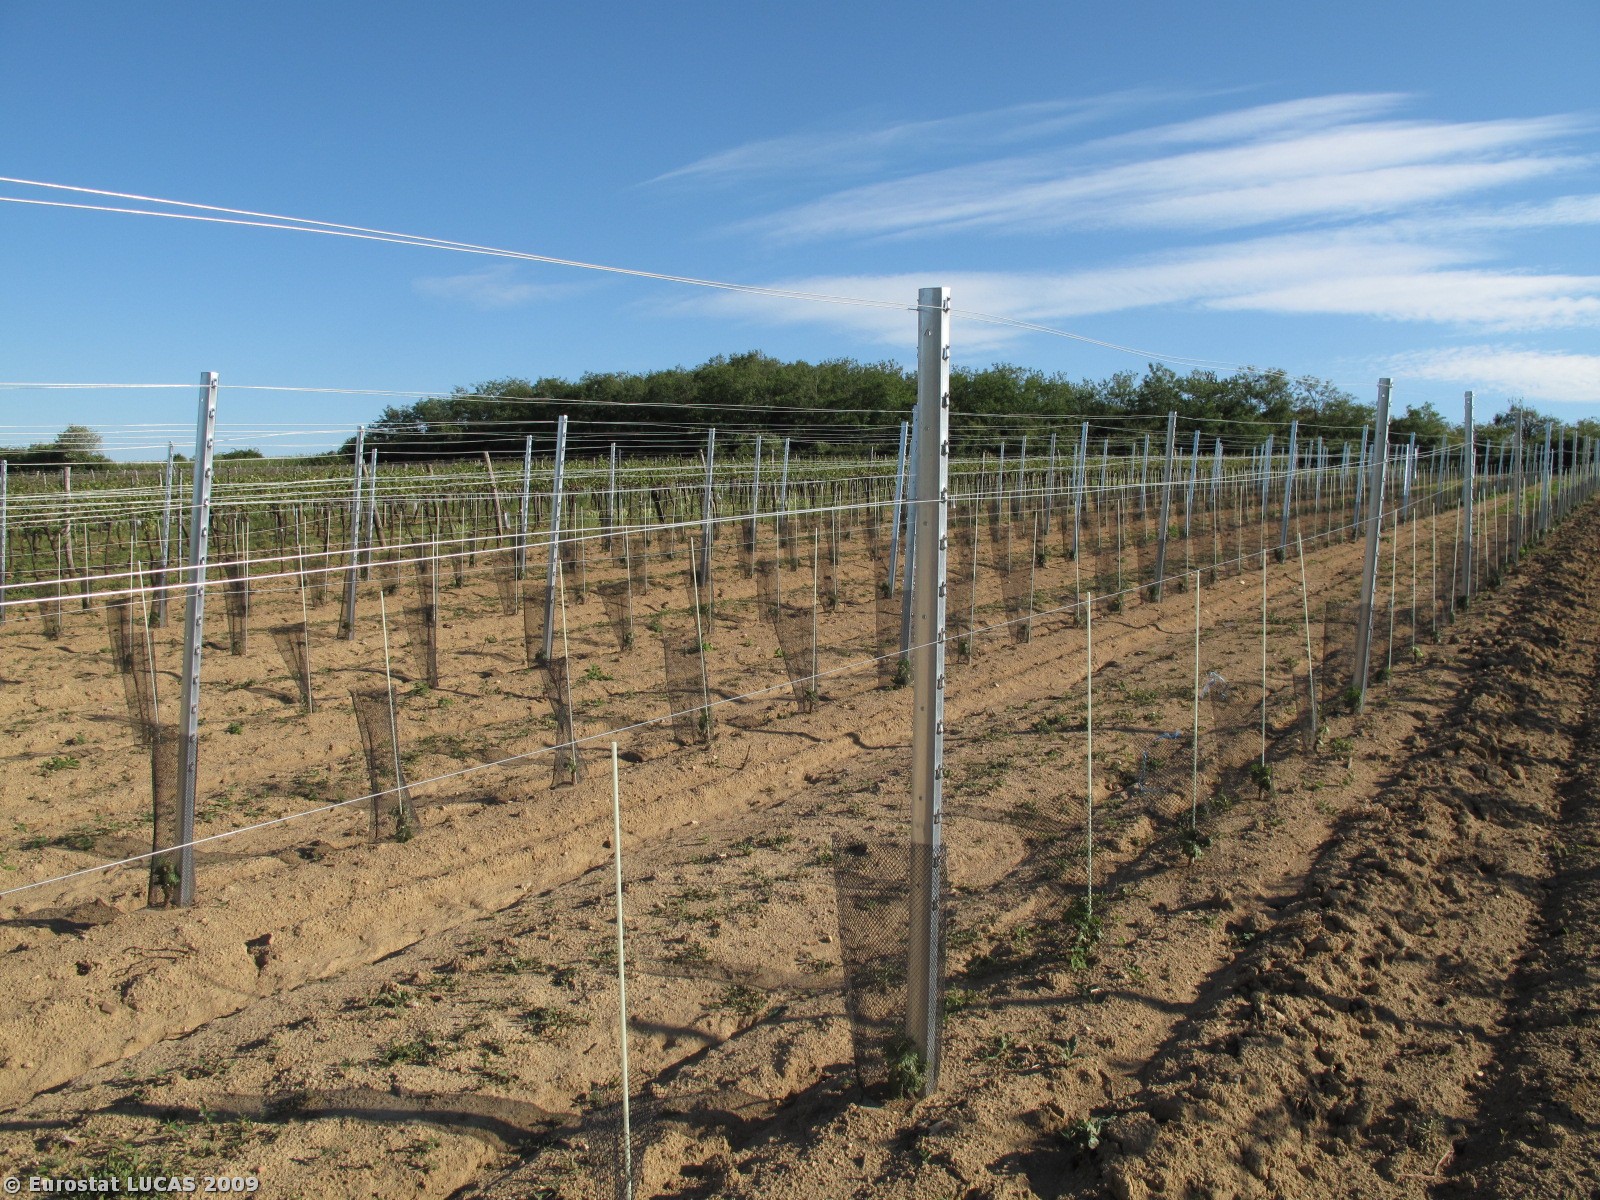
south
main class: Cropland
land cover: Vineyards
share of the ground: 10 - 25 %
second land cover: Bare land
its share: > 75 %
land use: Agriculture (excluding fallow land and kitchen gardens)
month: June
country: AT
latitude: 48.7500
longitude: 15.9207
